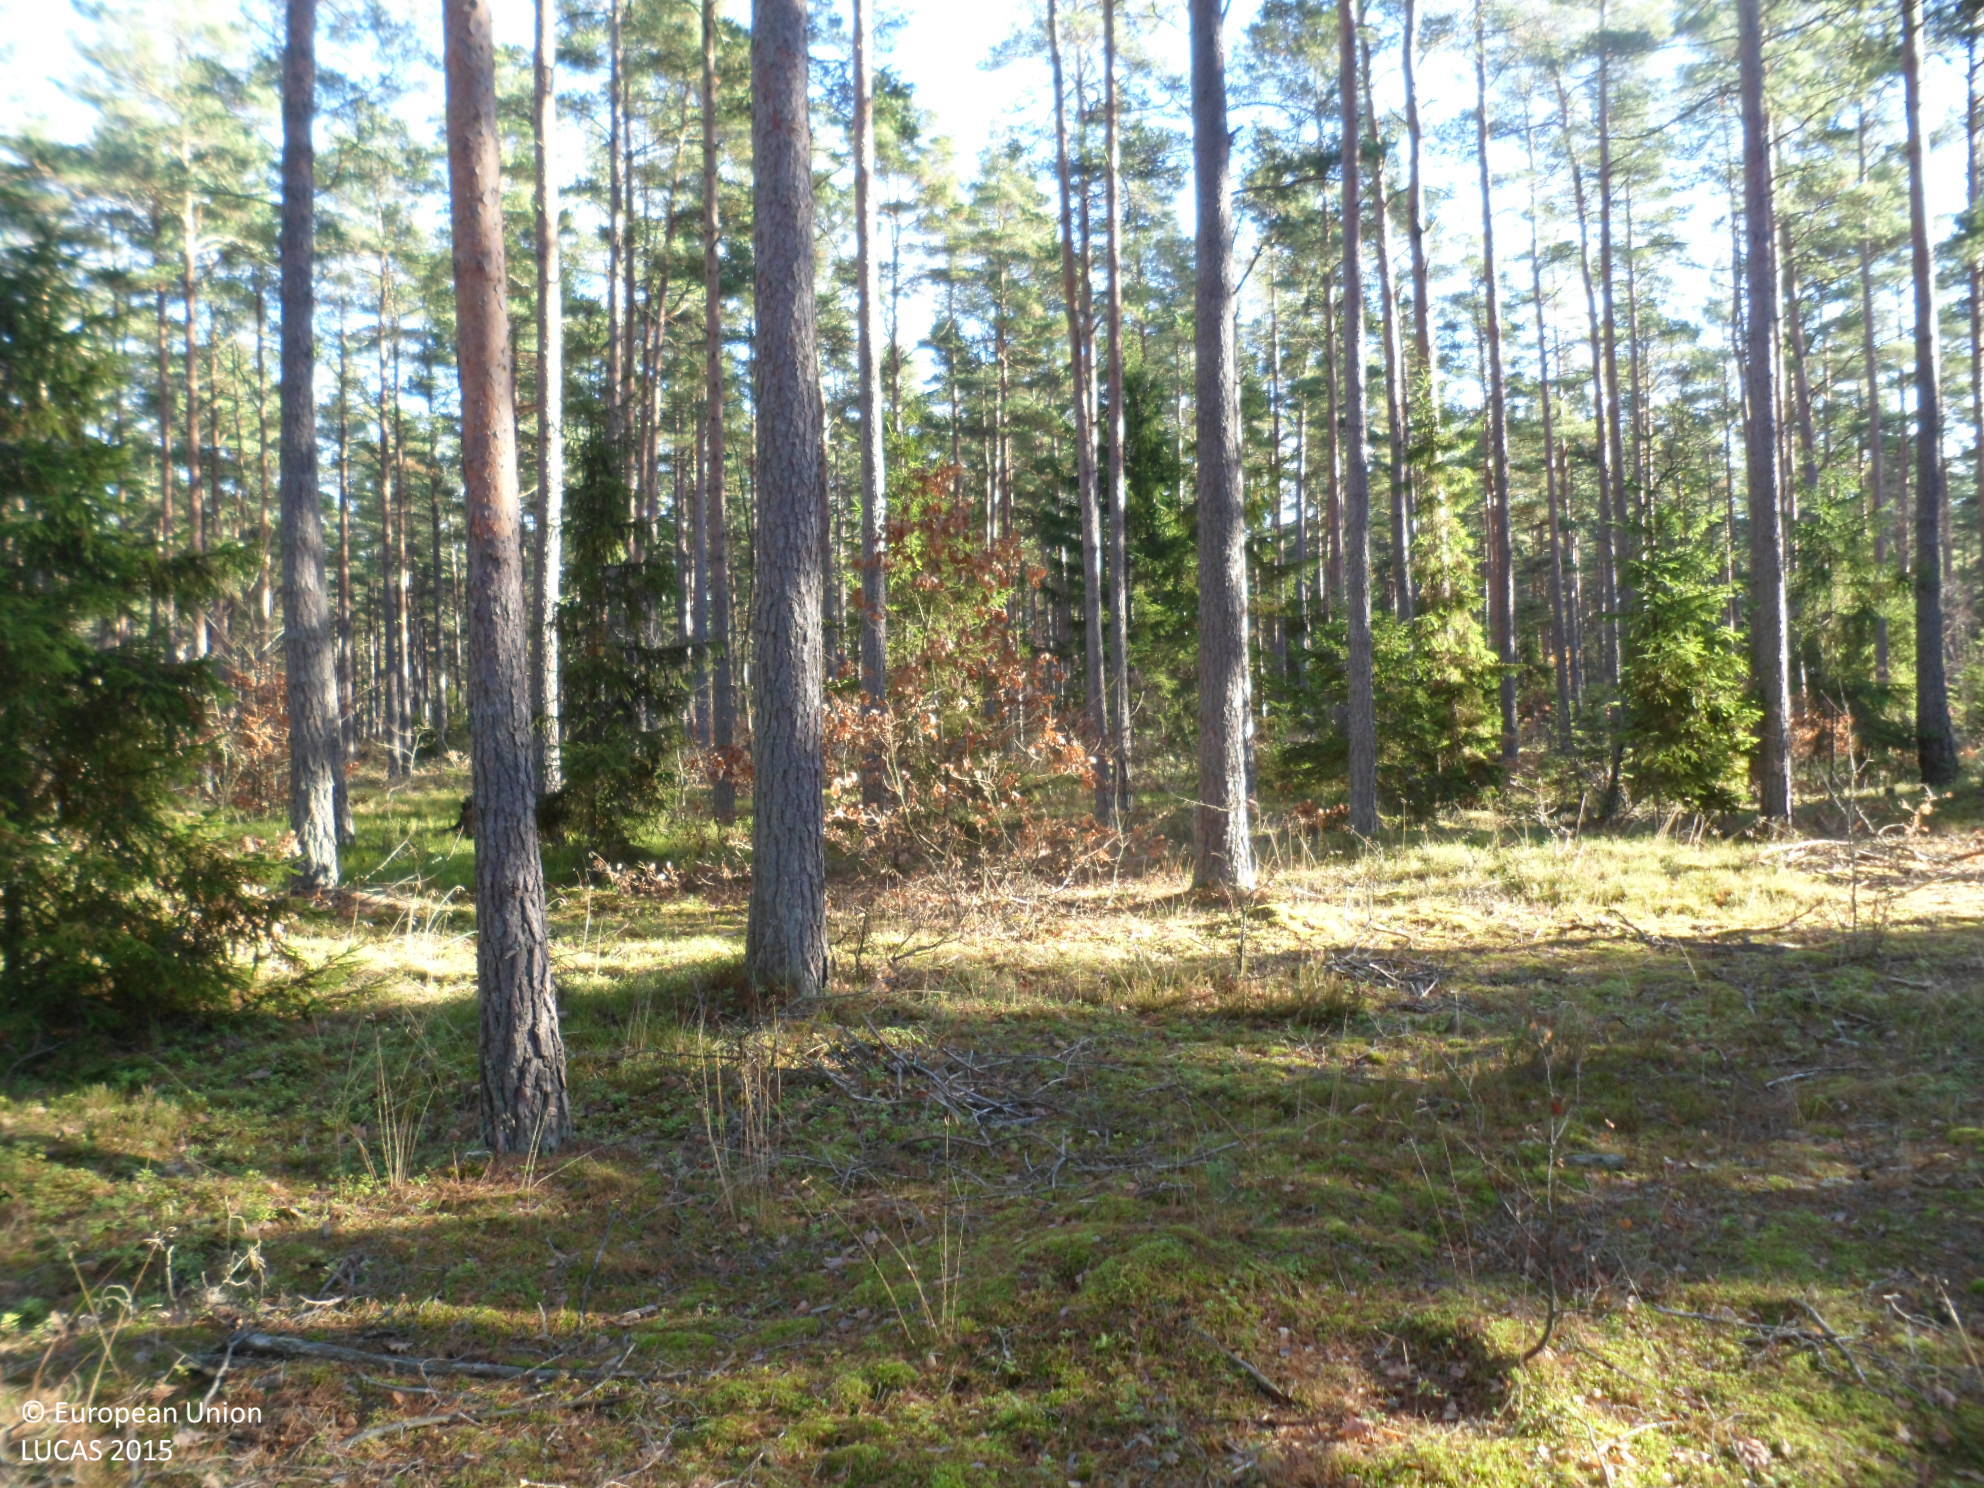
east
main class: Woodland
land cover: Pine dominated coniferous woodland
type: boreal forest
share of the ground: 50 - 75 %
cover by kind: coniferous forest trees 50 %, shrubs 30 %, lichens and mosses 15 %, broadleaved forest trees 5 %
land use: Forestry
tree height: > 5 m
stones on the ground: 25 - 50 %
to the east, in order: Pine dominated coniferous woodland; Tracks; Pine dominated coniferous woodland
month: November
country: SE
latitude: 56.6014
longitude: 16.1086
